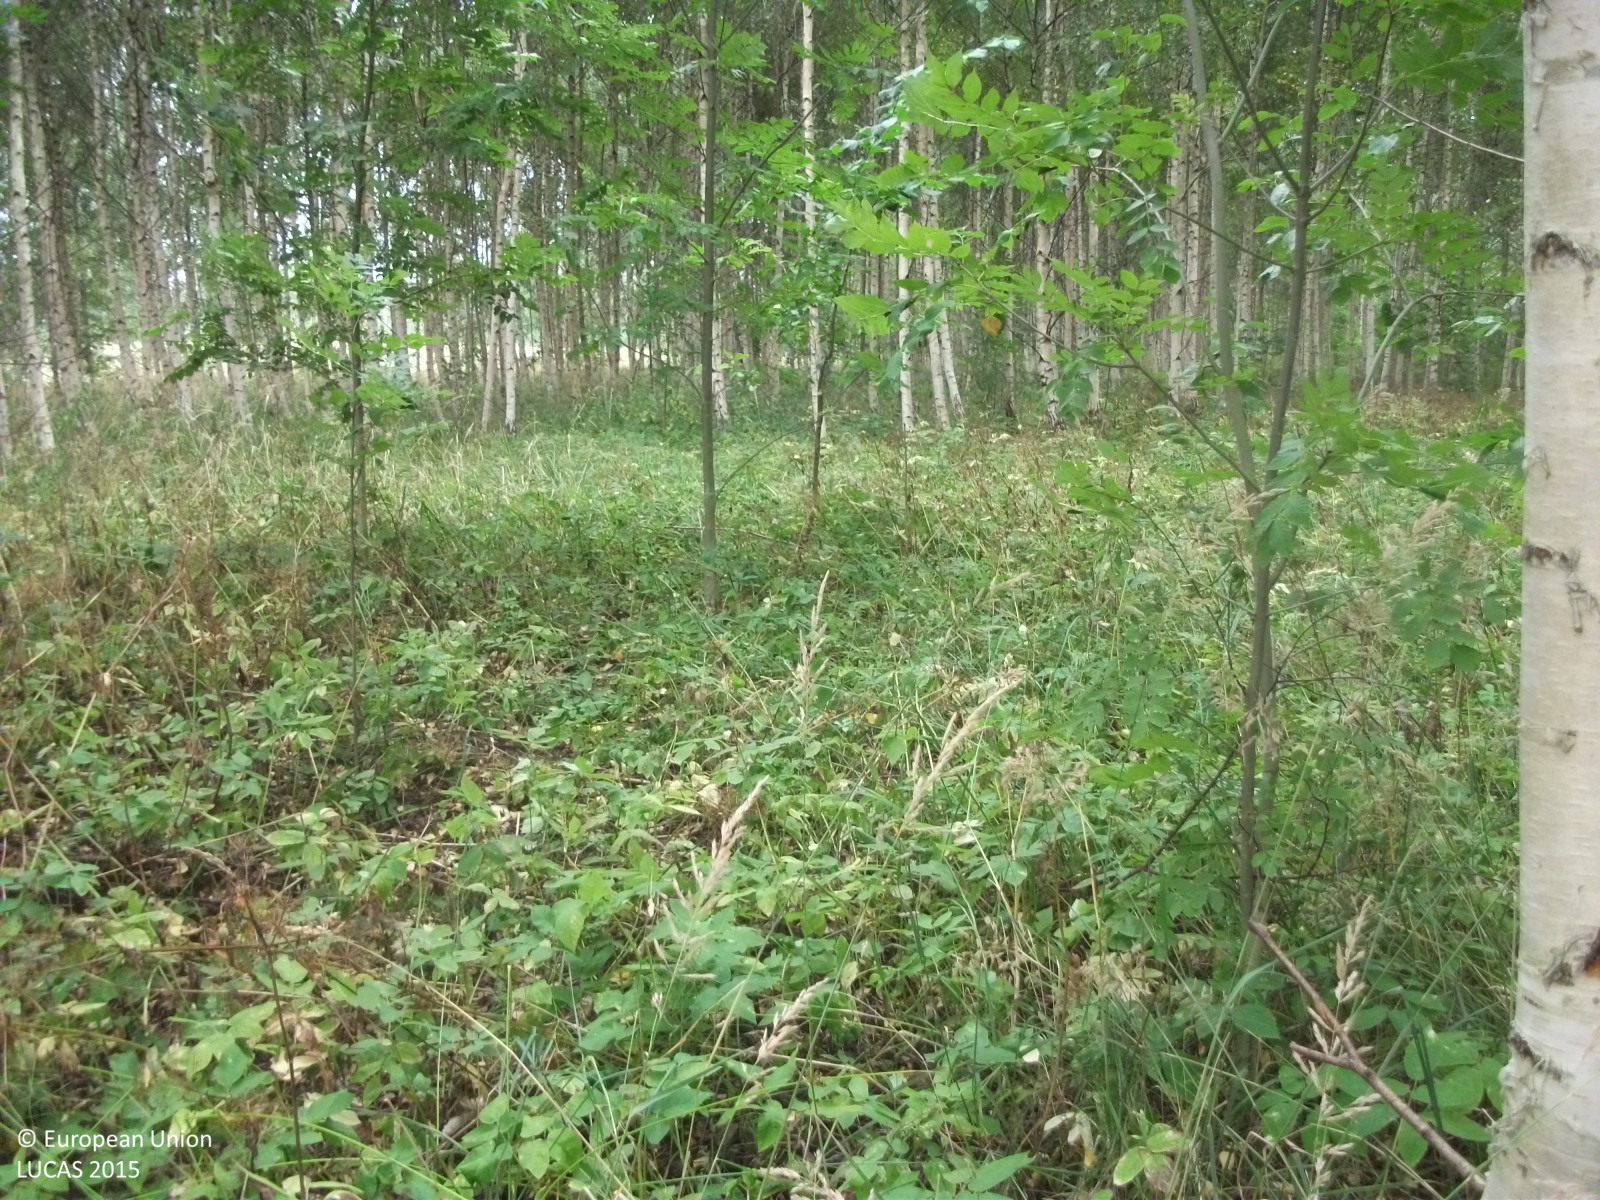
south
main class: Woodland
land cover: Broadleaved woodland
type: non-riverine alder, birch or aspen forest
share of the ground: 50 - 75 %
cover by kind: broadleaved forest trees 60 %, herbaceous plants 30 %, shrubs 10 %
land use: Forestry
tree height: > 5 m
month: September
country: LV
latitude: 57.4757
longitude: 24.7211
